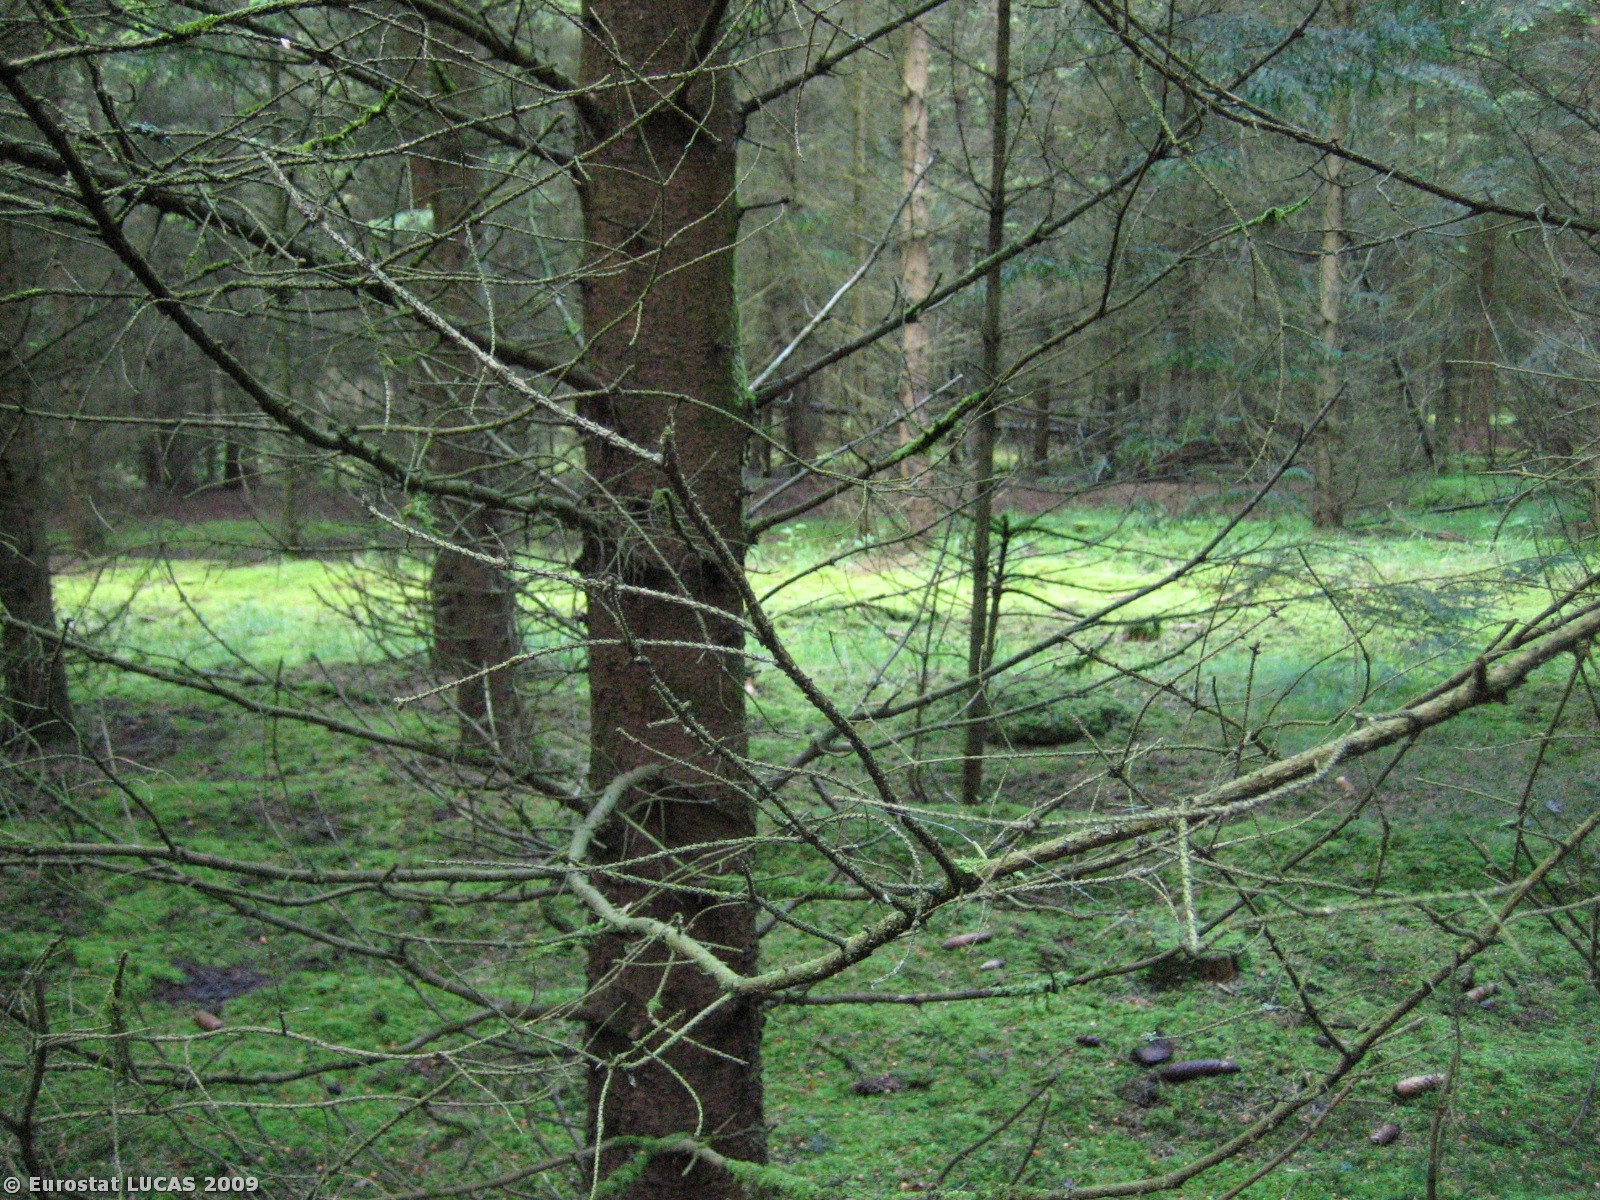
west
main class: Woodland
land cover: Coniferous woodland
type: hemiboreal forest and nemoral coniferous forest and mixed broadleaved-coniferous forest
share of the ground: > 75 %
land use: Forestry
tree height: > 5 m
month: May
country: DK
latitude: 55.8623
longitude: 9.3137
